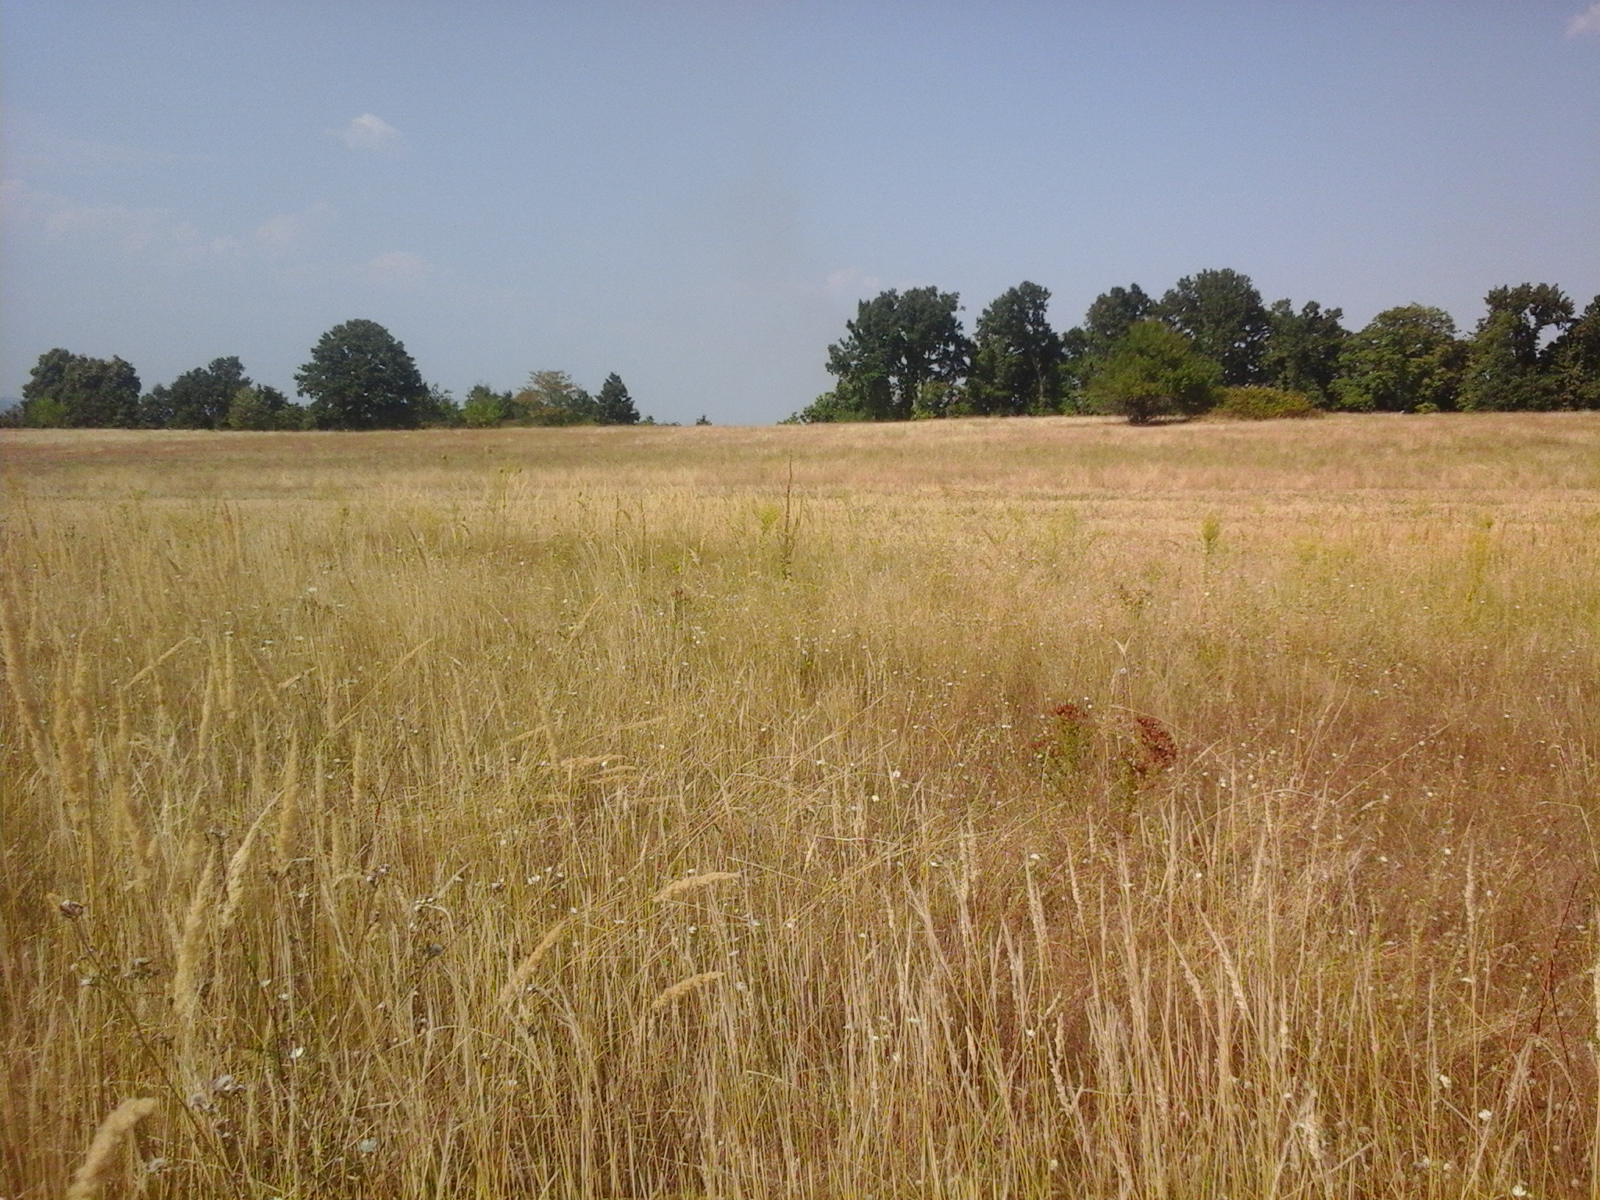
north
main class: Cropland
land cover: Maize
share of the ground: > 75 %
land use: Agriculture (excluding fallow land and kitchen gardens)
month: August
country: RO
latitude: 44.4672
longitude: 22.4948
